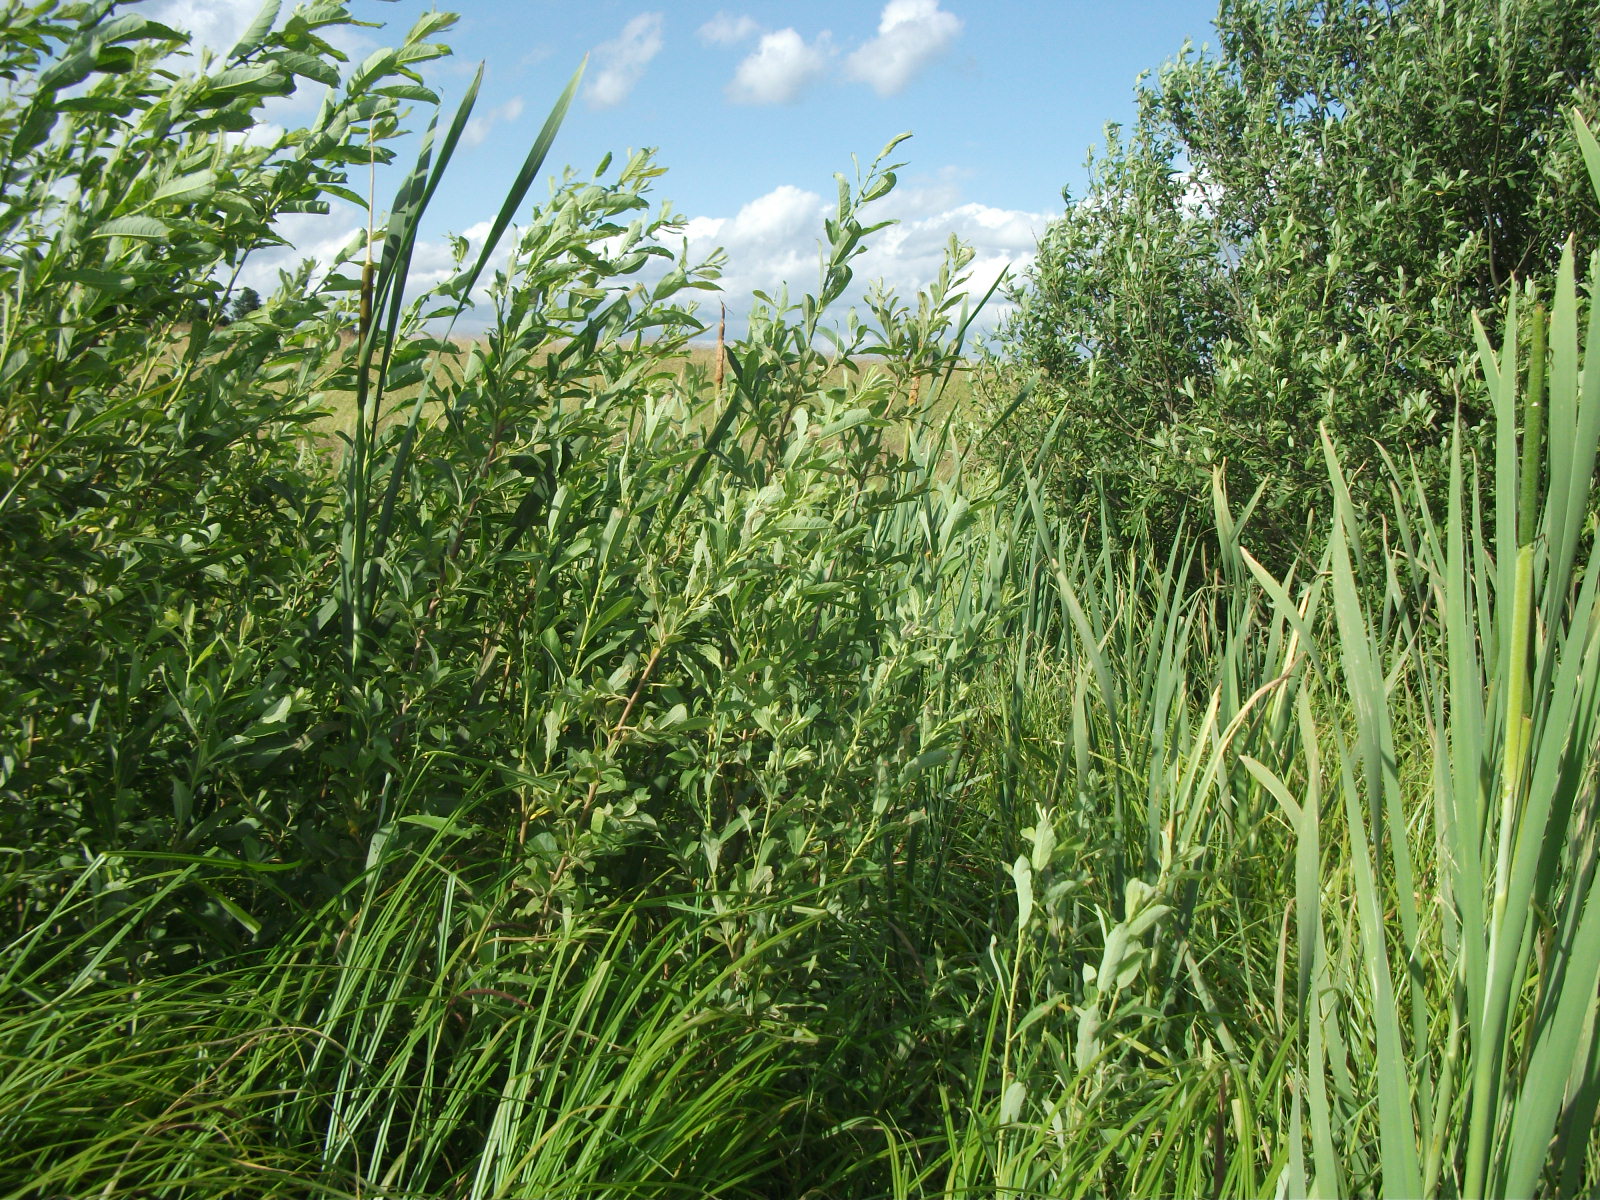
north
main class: Woodland
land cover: Broadleaved woodland
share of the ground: 50 - 75 %
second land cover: Spontaneously vegetated surfaces
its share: 50 - 75 %
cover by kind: broadleaved forest trees 50 %, shrubs 30 %, herbaceous plants 20 %
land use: Agriculture (excluding fallow land and kitchen gardens)
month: July
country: LV
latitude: 57.1650
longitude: 25.9539
